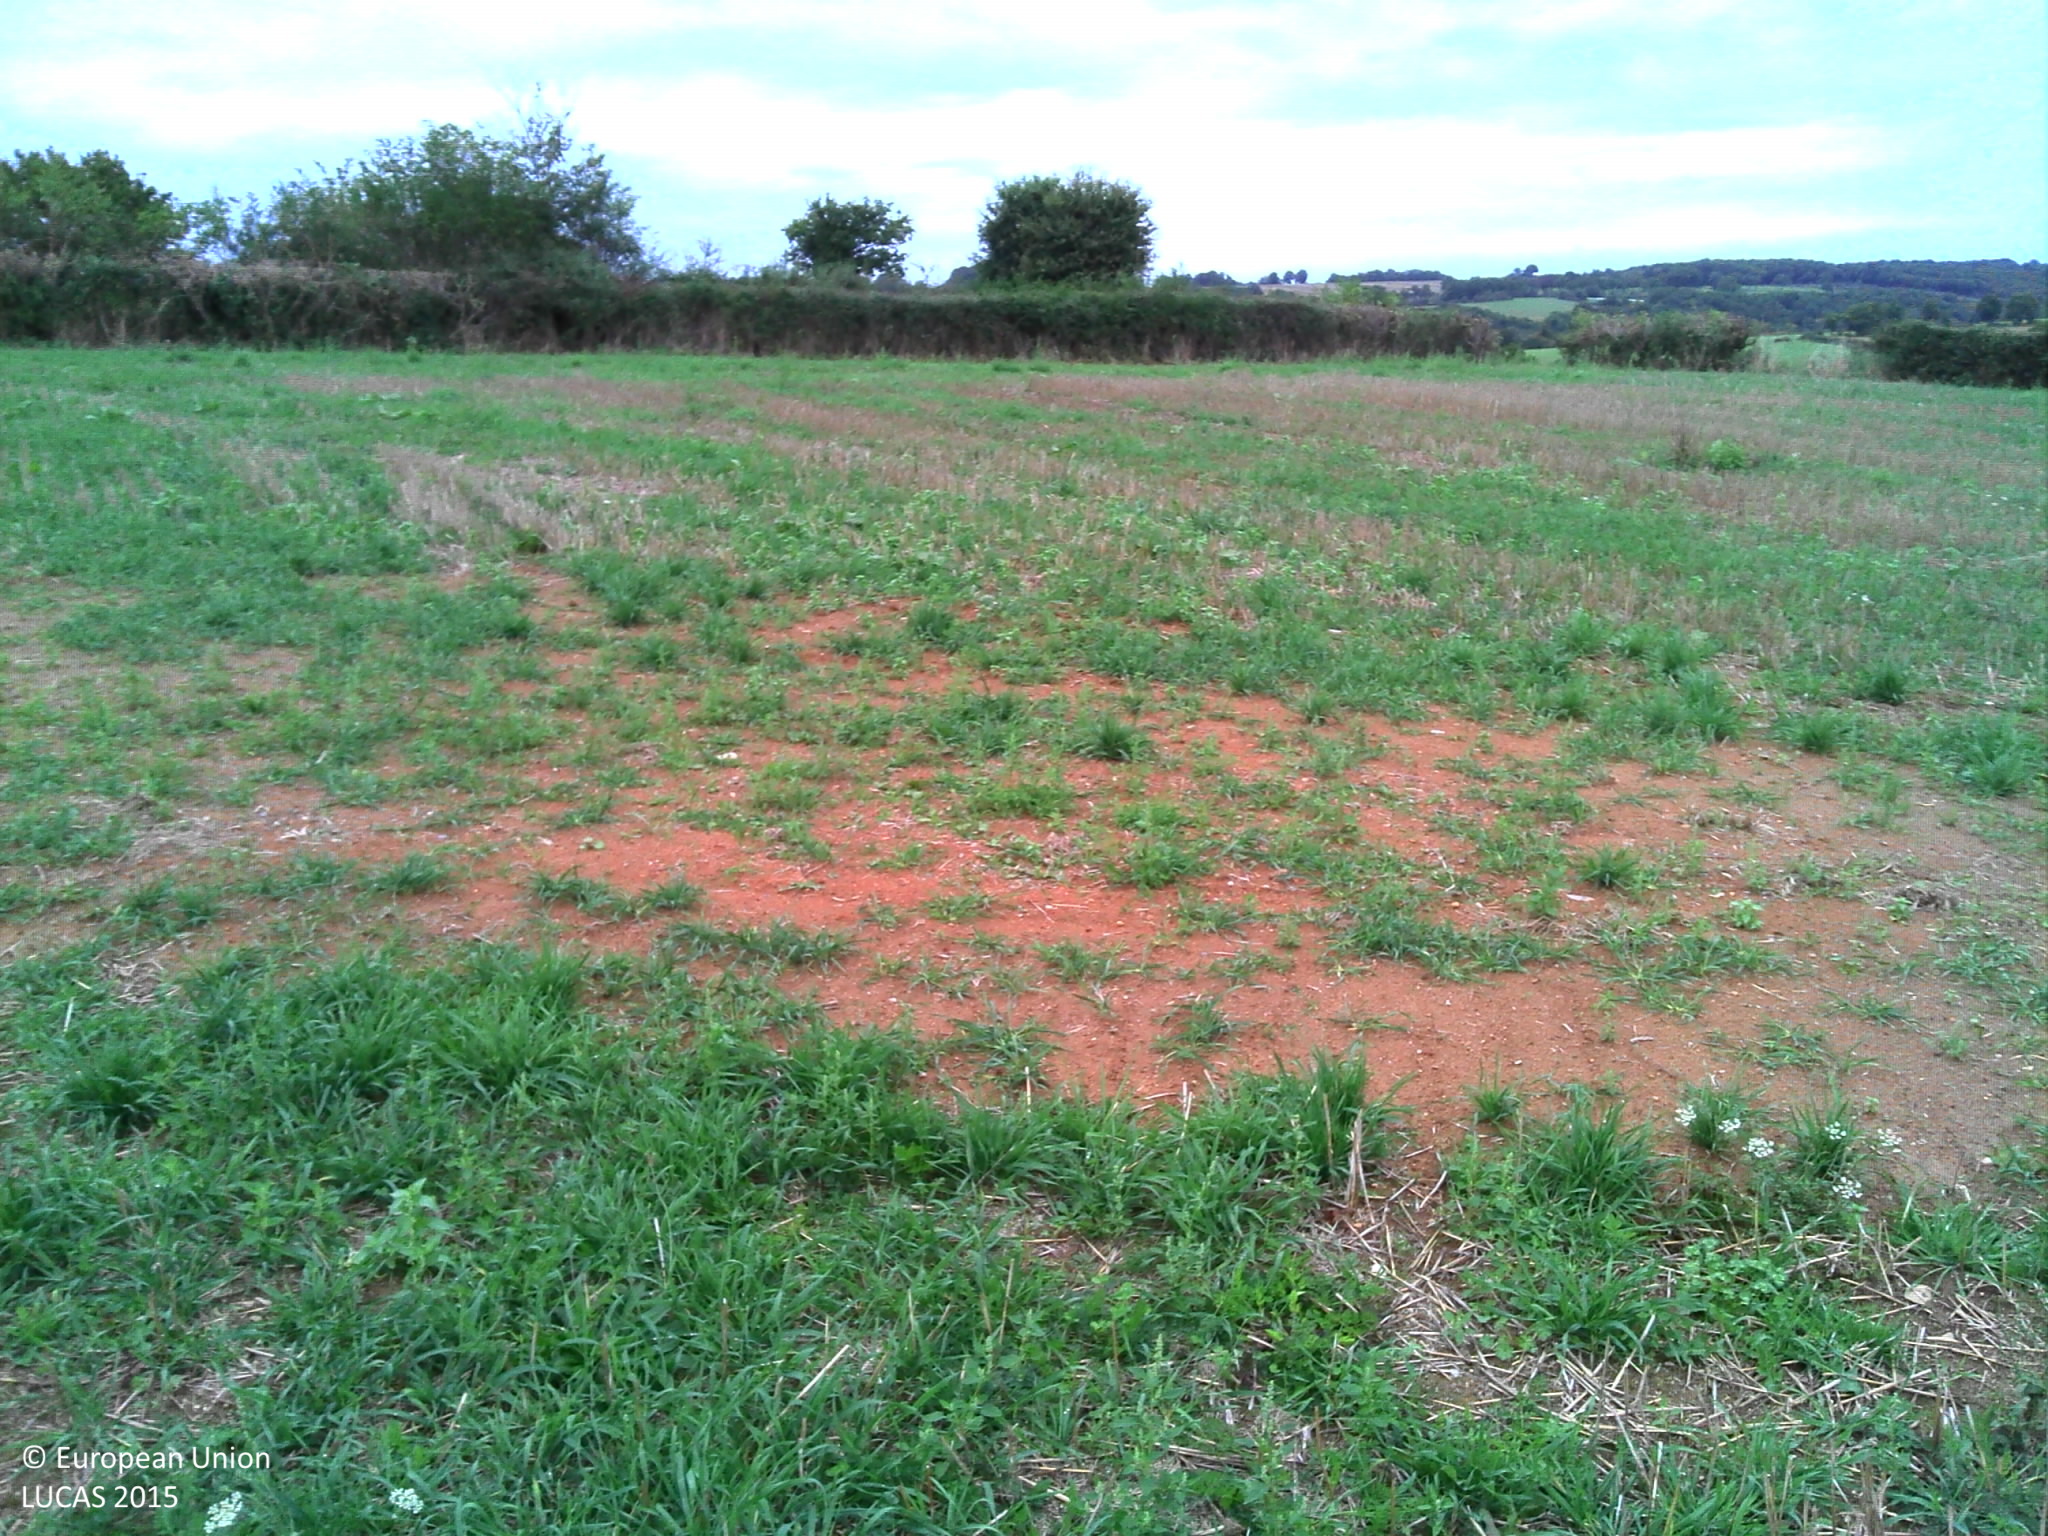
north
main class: Grassland
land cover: Spontaneously vegetated surfaces
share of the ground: 25 - 50 %
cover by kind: herbaceous plants 60 %, unconsolidated bare surface 40 %
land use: Agriculture (excluding fallow land and kitchen gardens)
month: September
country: FR
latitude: 46.5100
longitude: 1.6103
